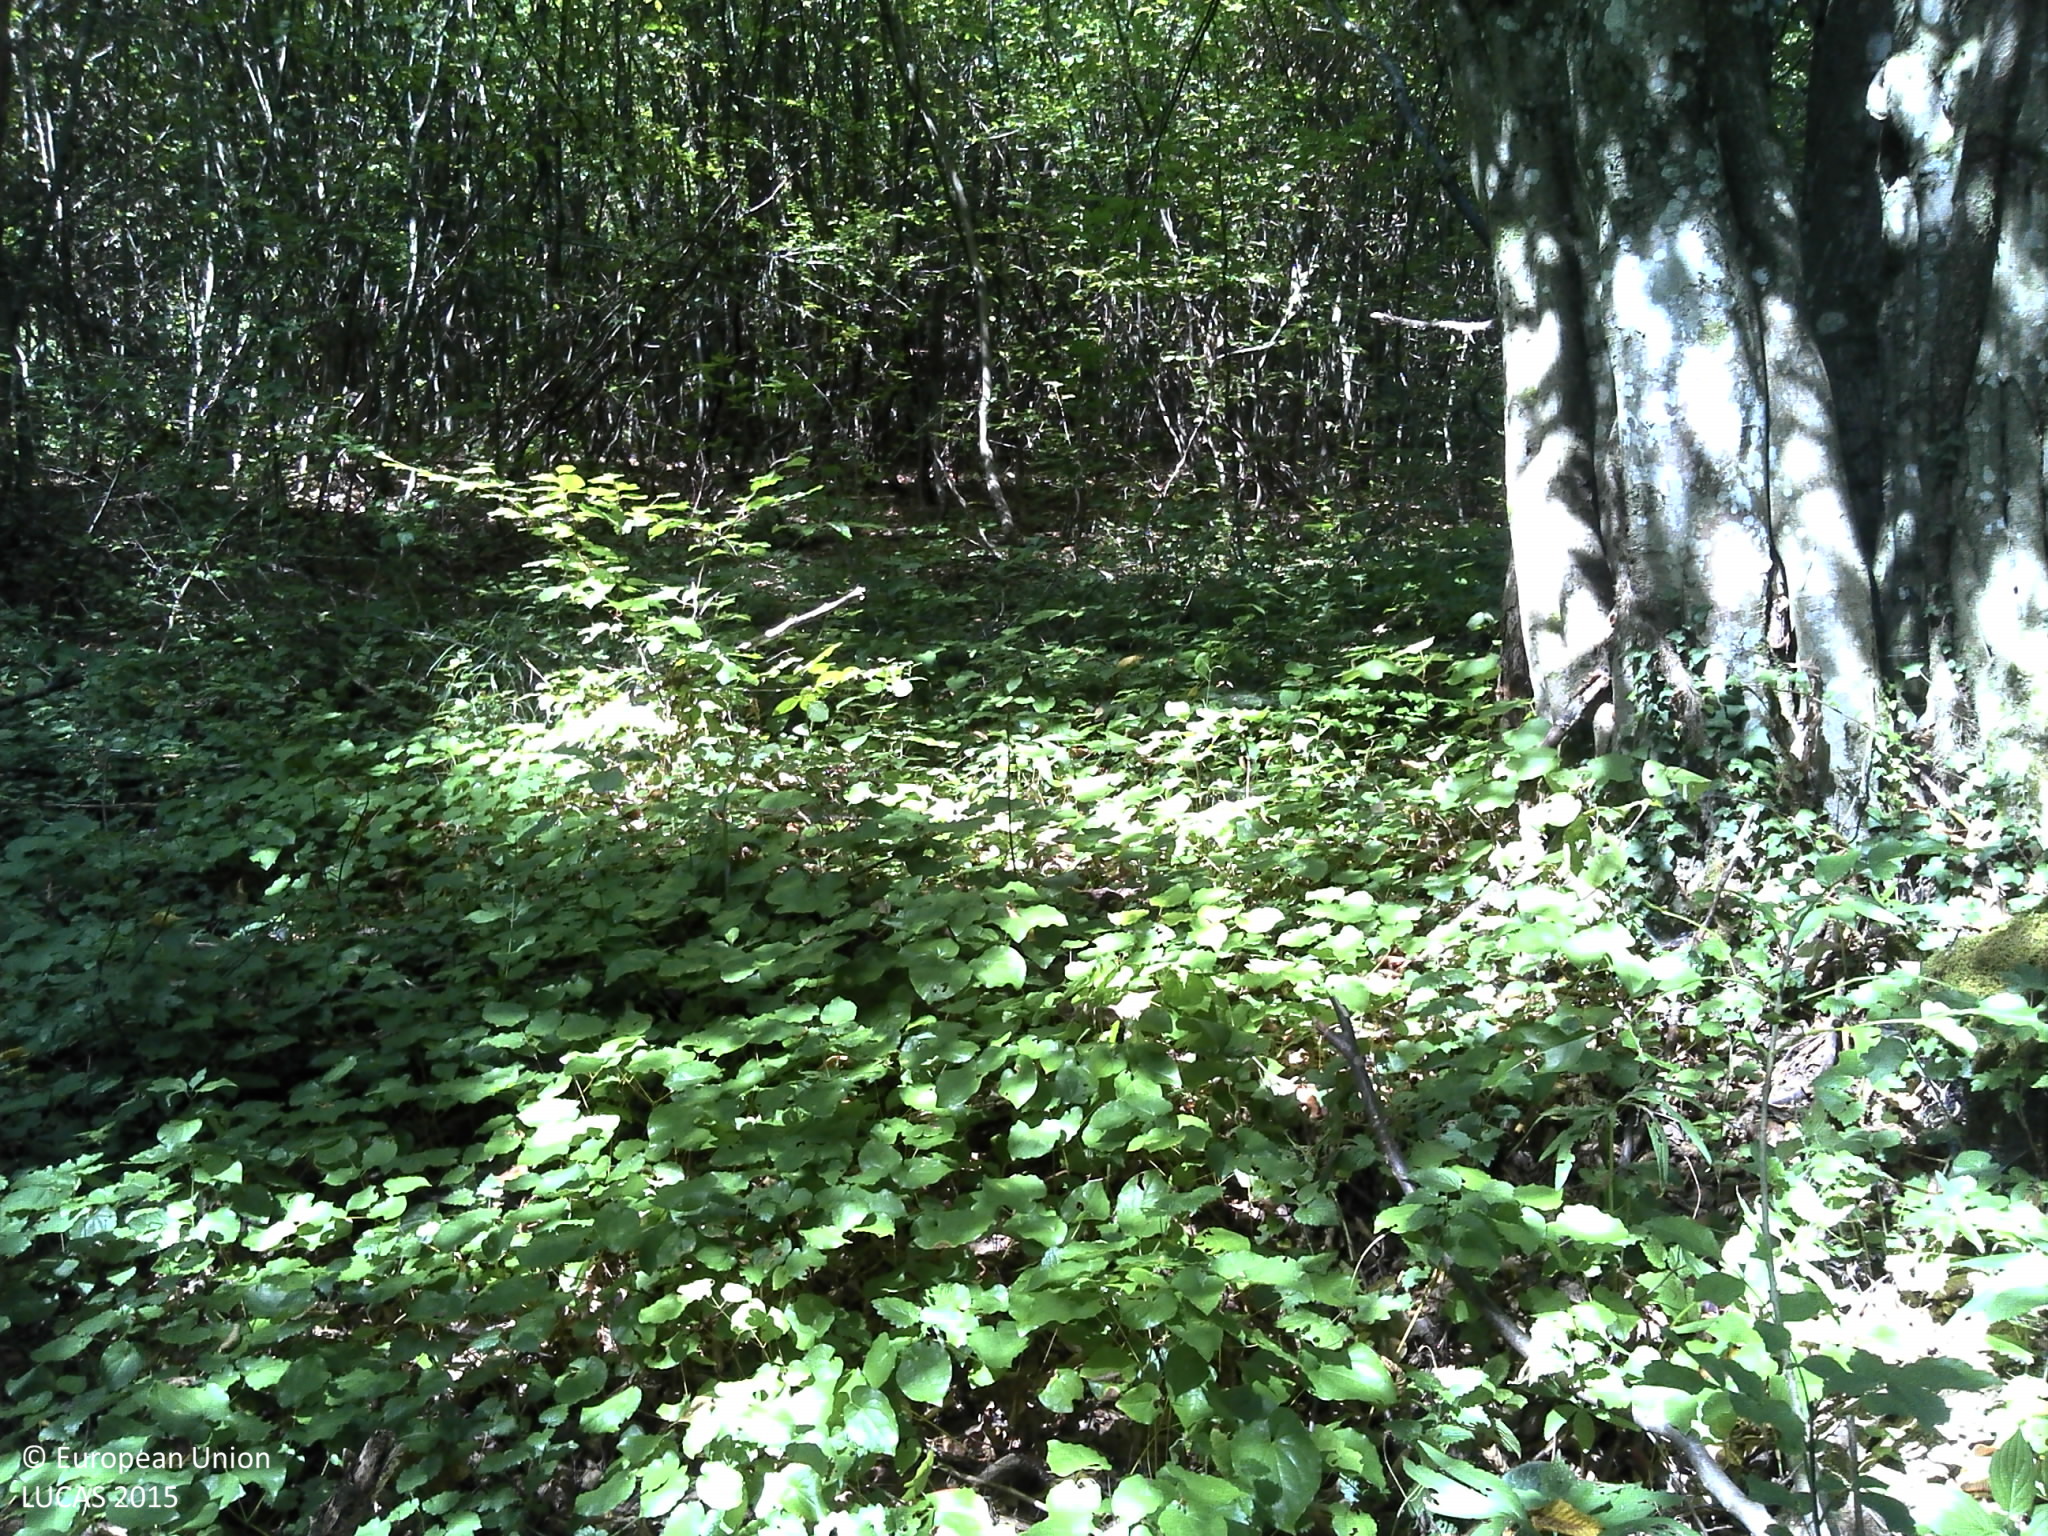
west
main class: Woodland
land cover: Broadleaved woodland
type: acidophilous oak and oak-birch forest
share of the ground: > 75 %
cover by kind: broadleaved forest trees 100 %
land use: Forestry
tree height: > 5 m
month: August
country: HR
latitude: 45.1764
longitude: 15.2250
